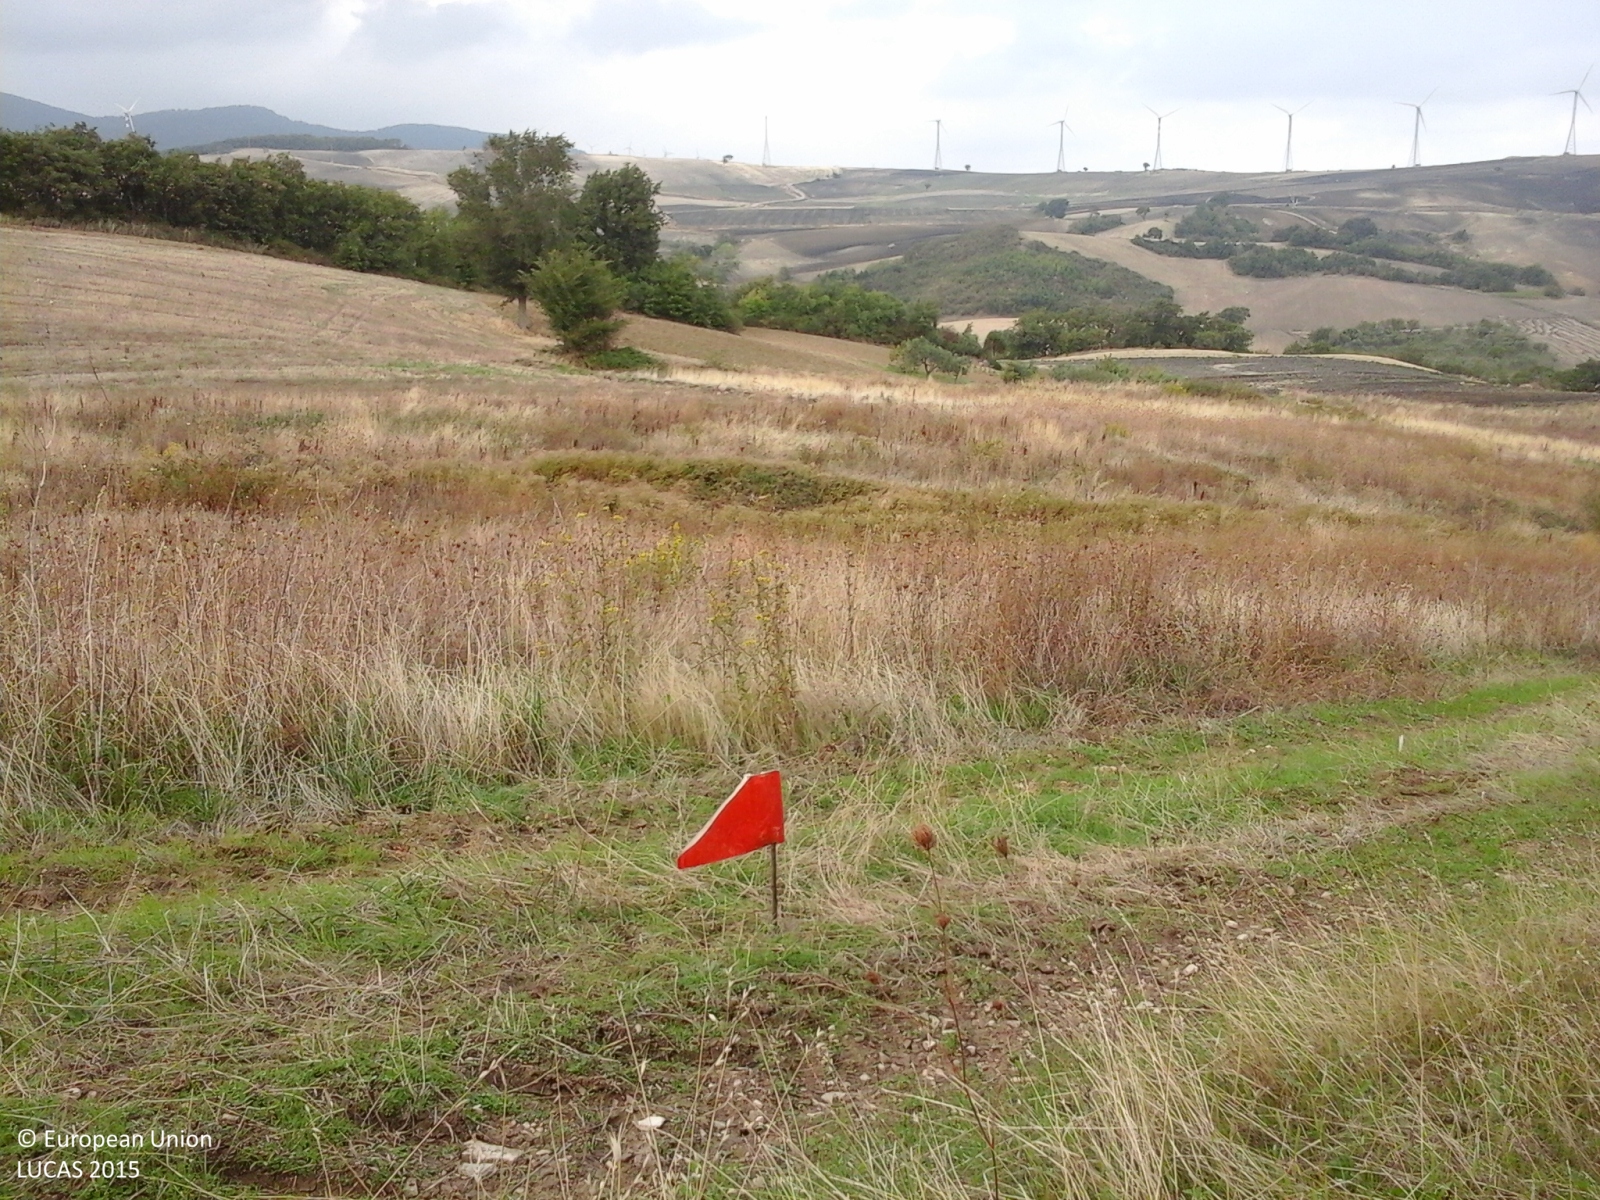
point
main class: Grassland
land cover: Spontaneously vegetated surfaces
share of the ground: > 75 %
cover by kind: herbaceous plants 100 %
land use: Fallow land
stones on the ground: < 10 %
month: October
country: IT
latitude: 41.5107
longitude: 15.1228
